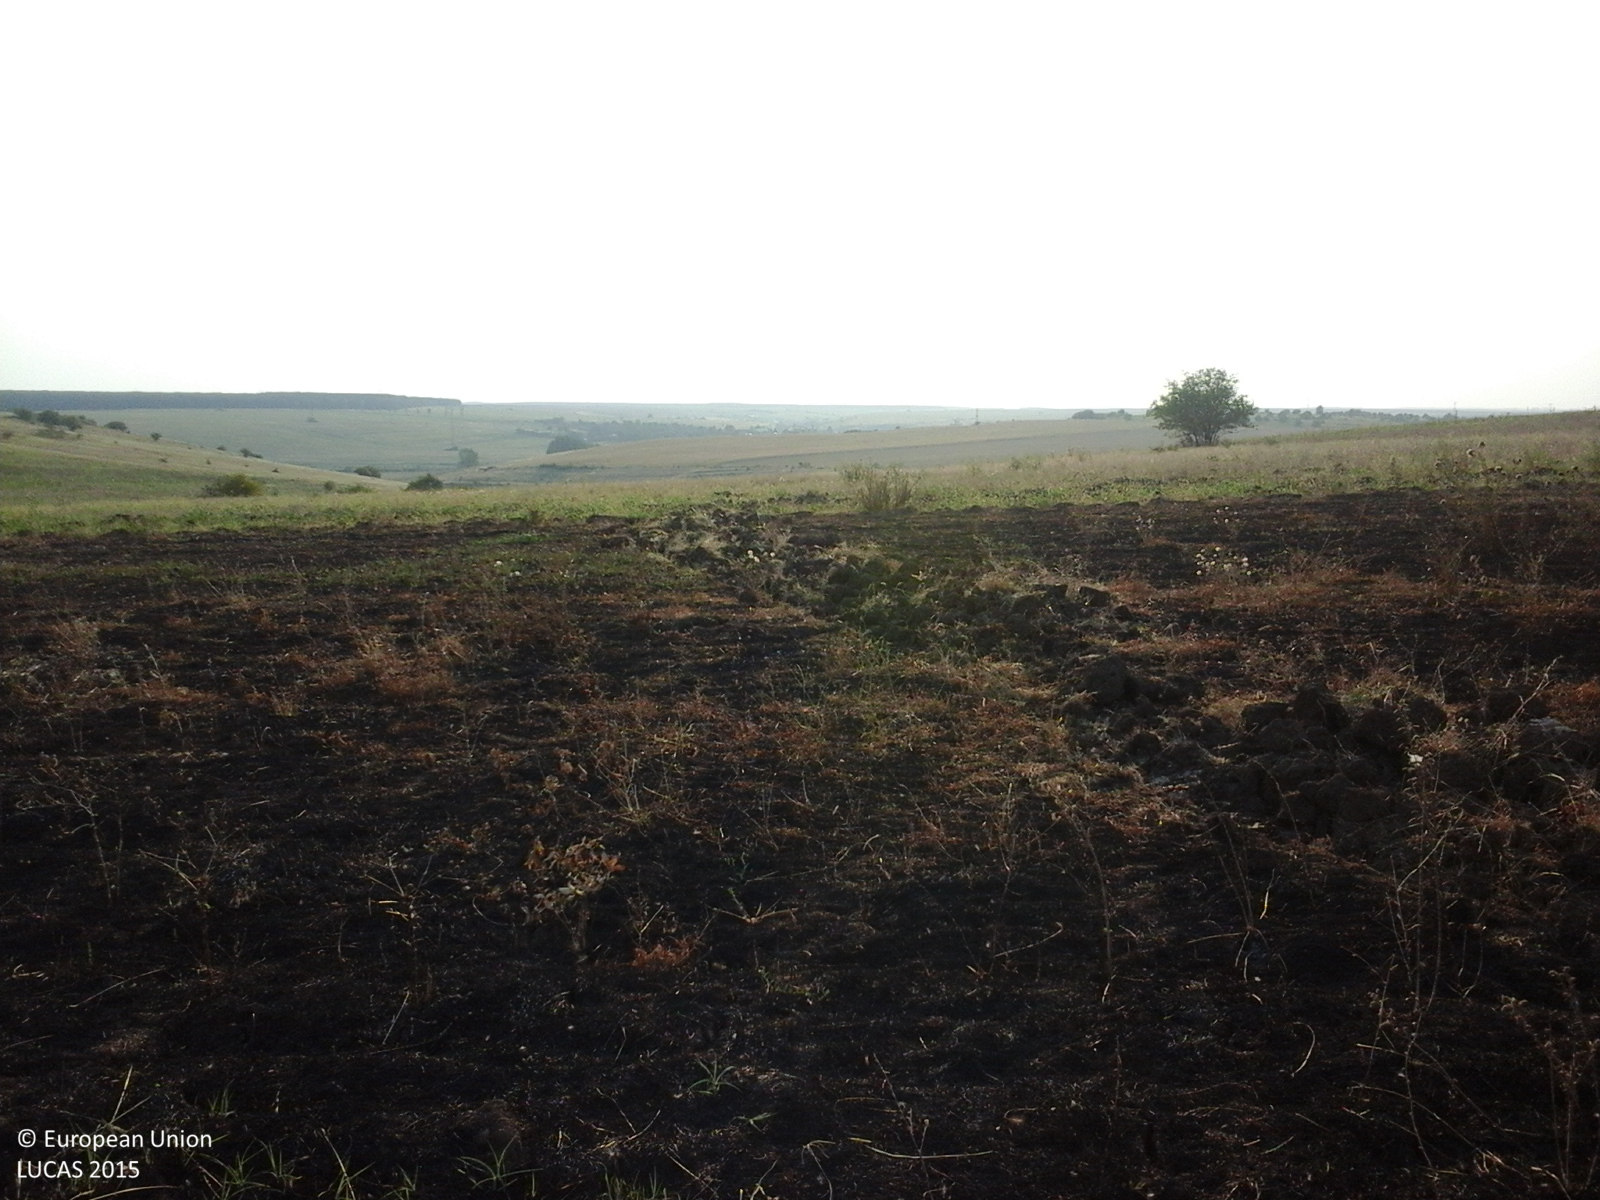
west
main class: Grassland
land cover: Spontaneously vegetated surfaces
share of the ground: > 75 %
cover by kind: herbaceous plants 100 %
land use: Fallow land
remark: Burnt area
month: August
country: RO
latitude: 44.2553
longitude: 23.5920
